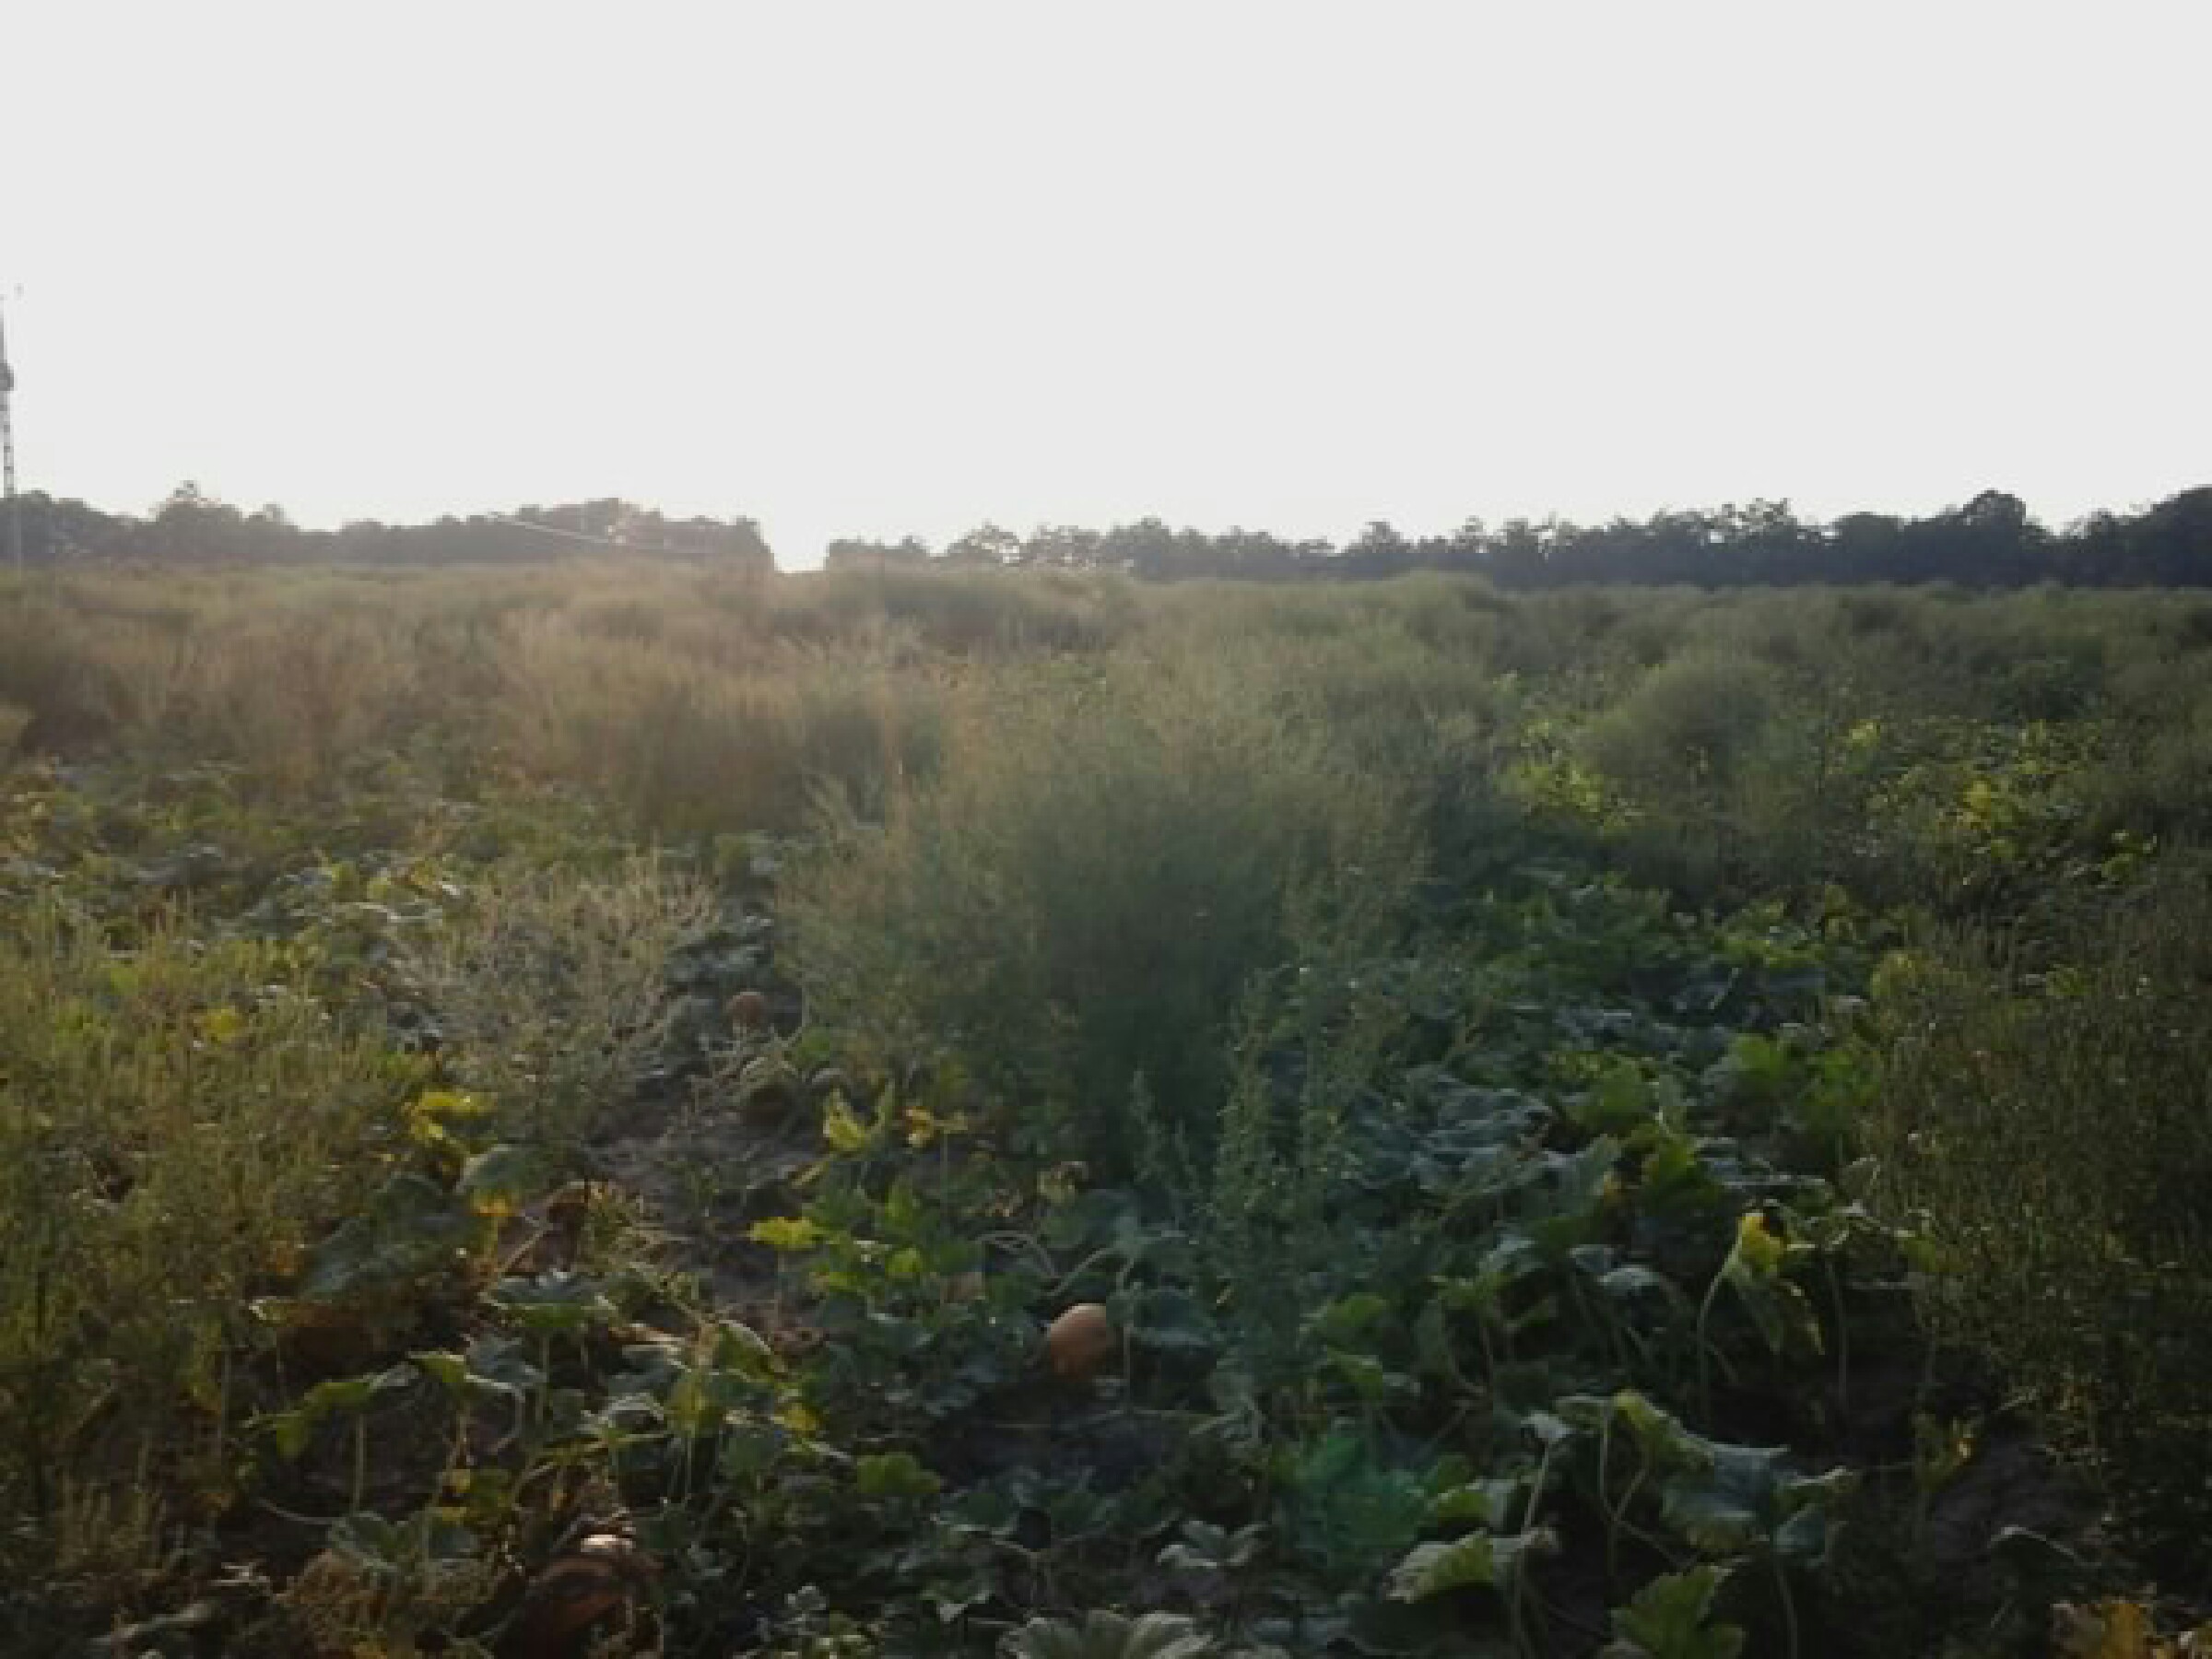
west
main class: Cropland
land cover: Other fresh vegetables
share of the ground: 25 - 50 %
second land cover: Spontaneously vegetated surfaces
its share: 25 - 50 %
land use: Agriculture (excluding fallow land and kitchen gardens)
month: August
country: HU
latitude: 48.0789
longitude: 19.3513
